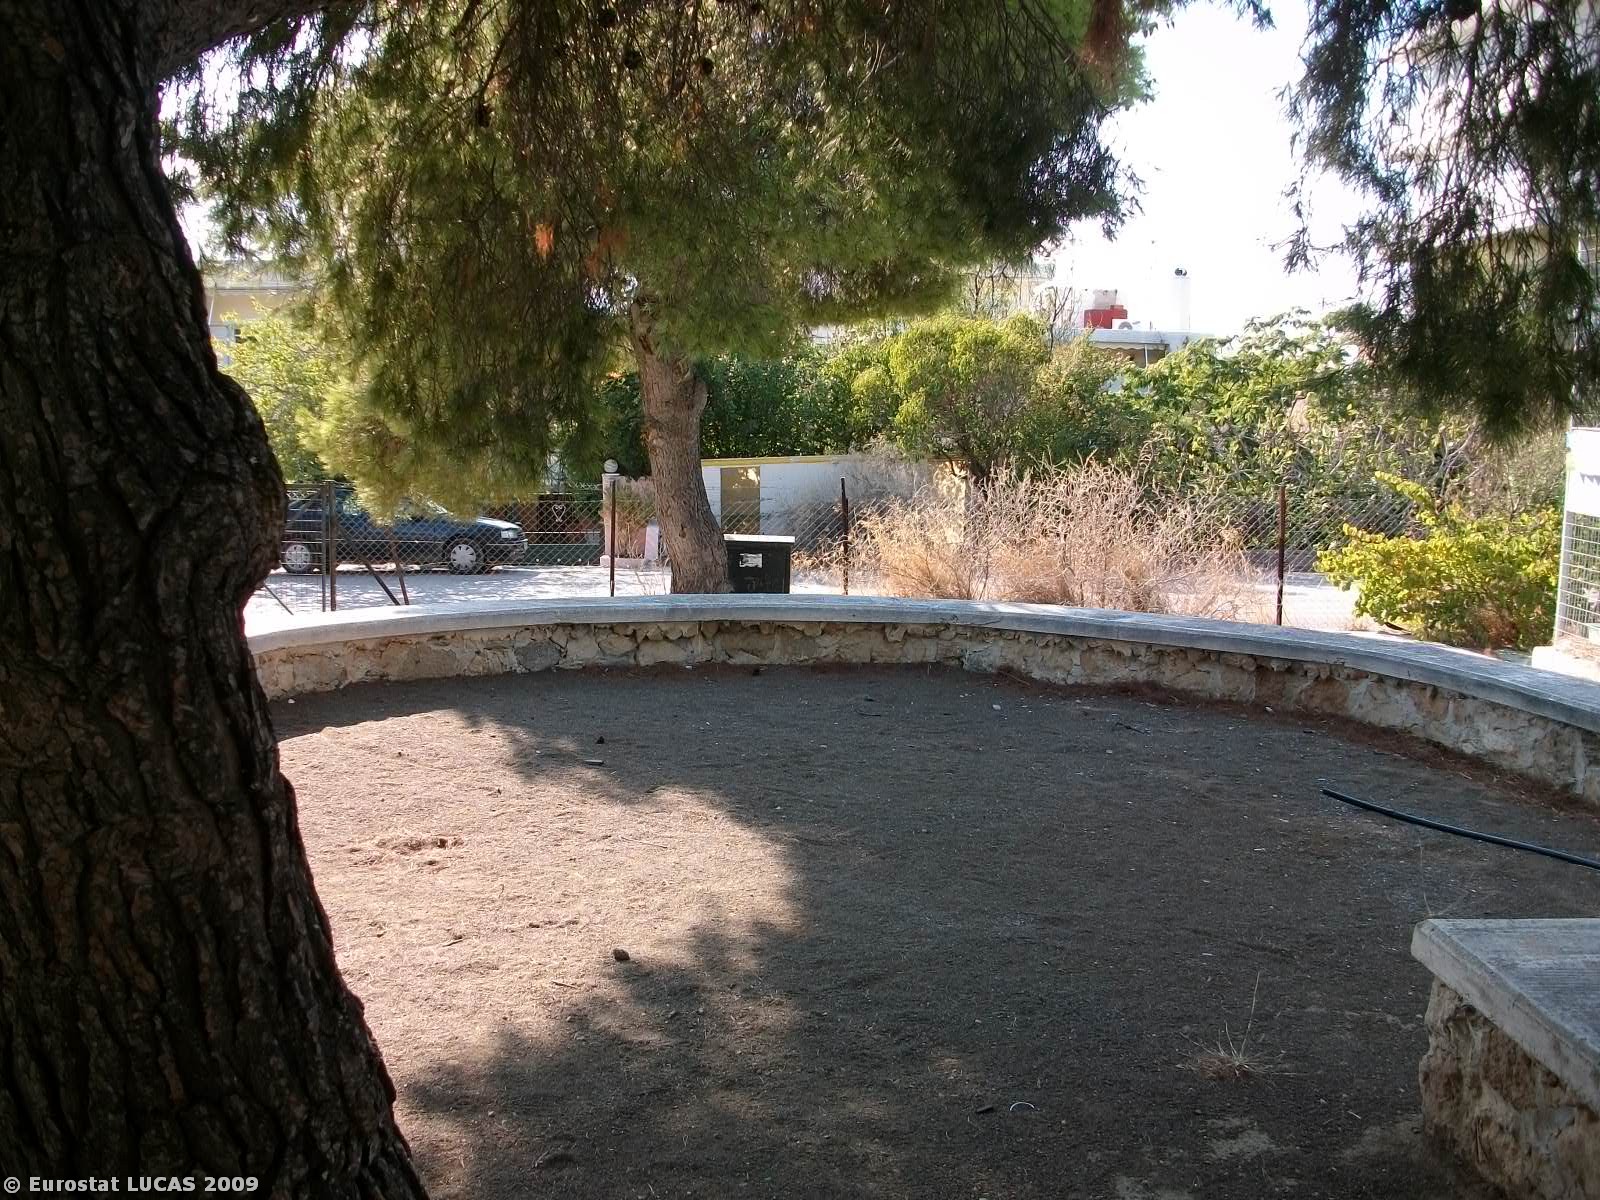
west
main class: Woodland
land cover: Coniferous woodland
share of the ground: > 75 %
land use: Amenities, museums, leisure
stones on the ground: < 10 %
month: September
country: GR
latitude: 37.9718
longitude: 22.9845
